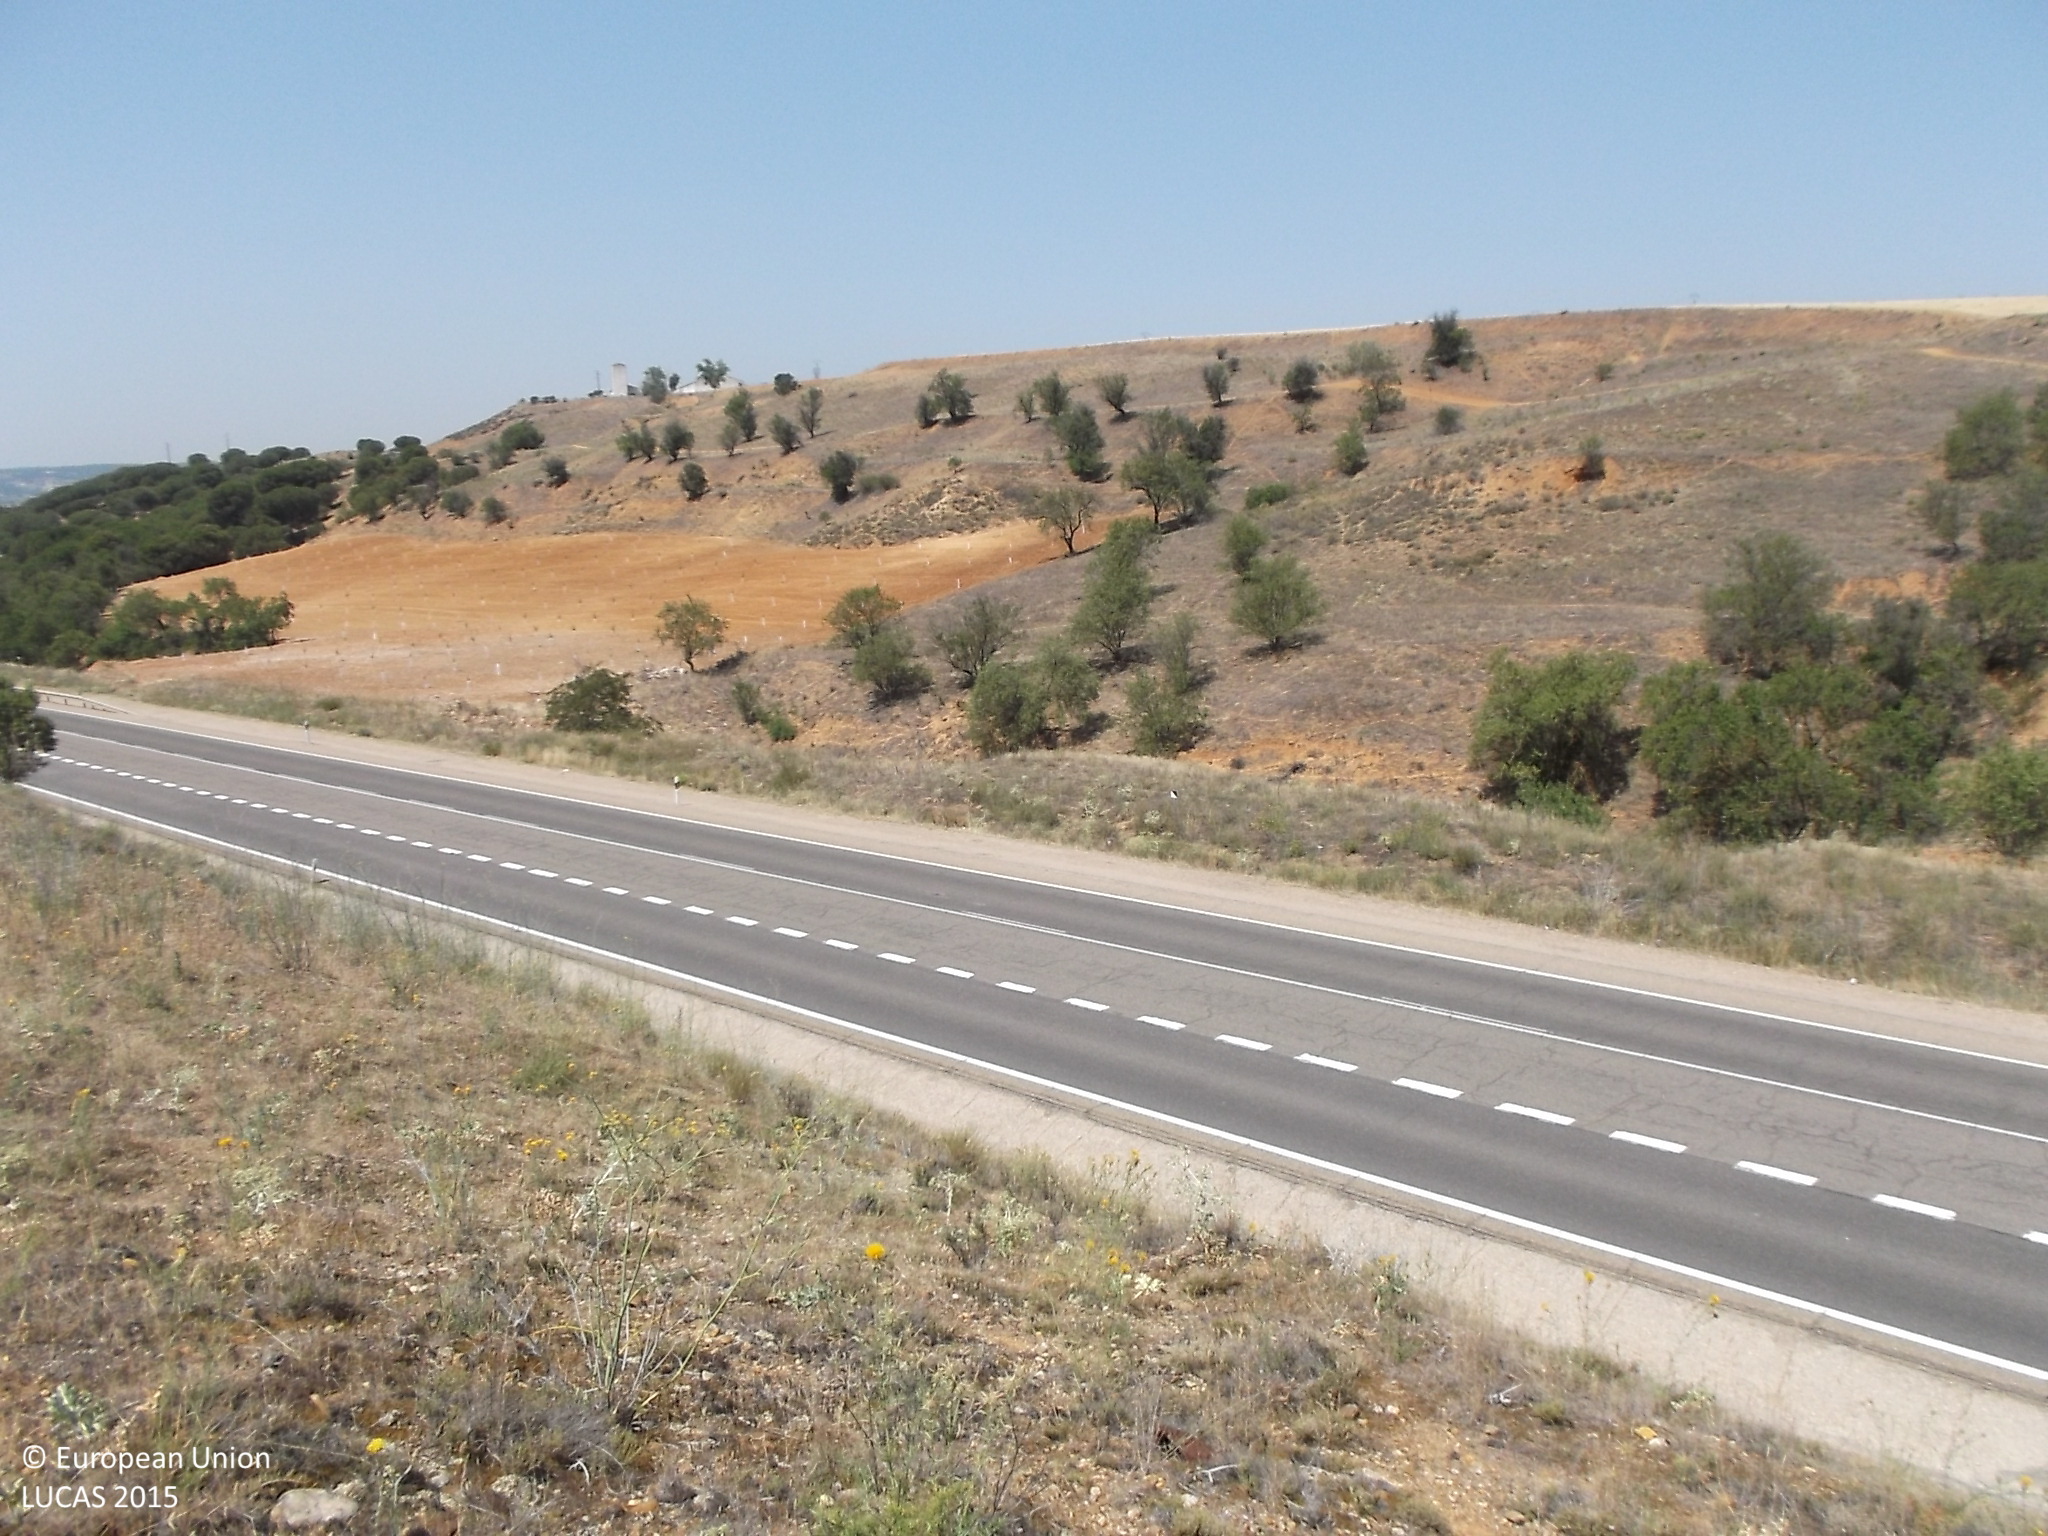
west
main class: Grassland
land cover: Grassland without tree/shrub cover
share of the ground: > 75 %
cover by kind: herbaceous plants 100 %
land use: Semi-natural and natural areas not in use
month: July
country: ES
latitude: 41.5221
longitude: -5.4069
